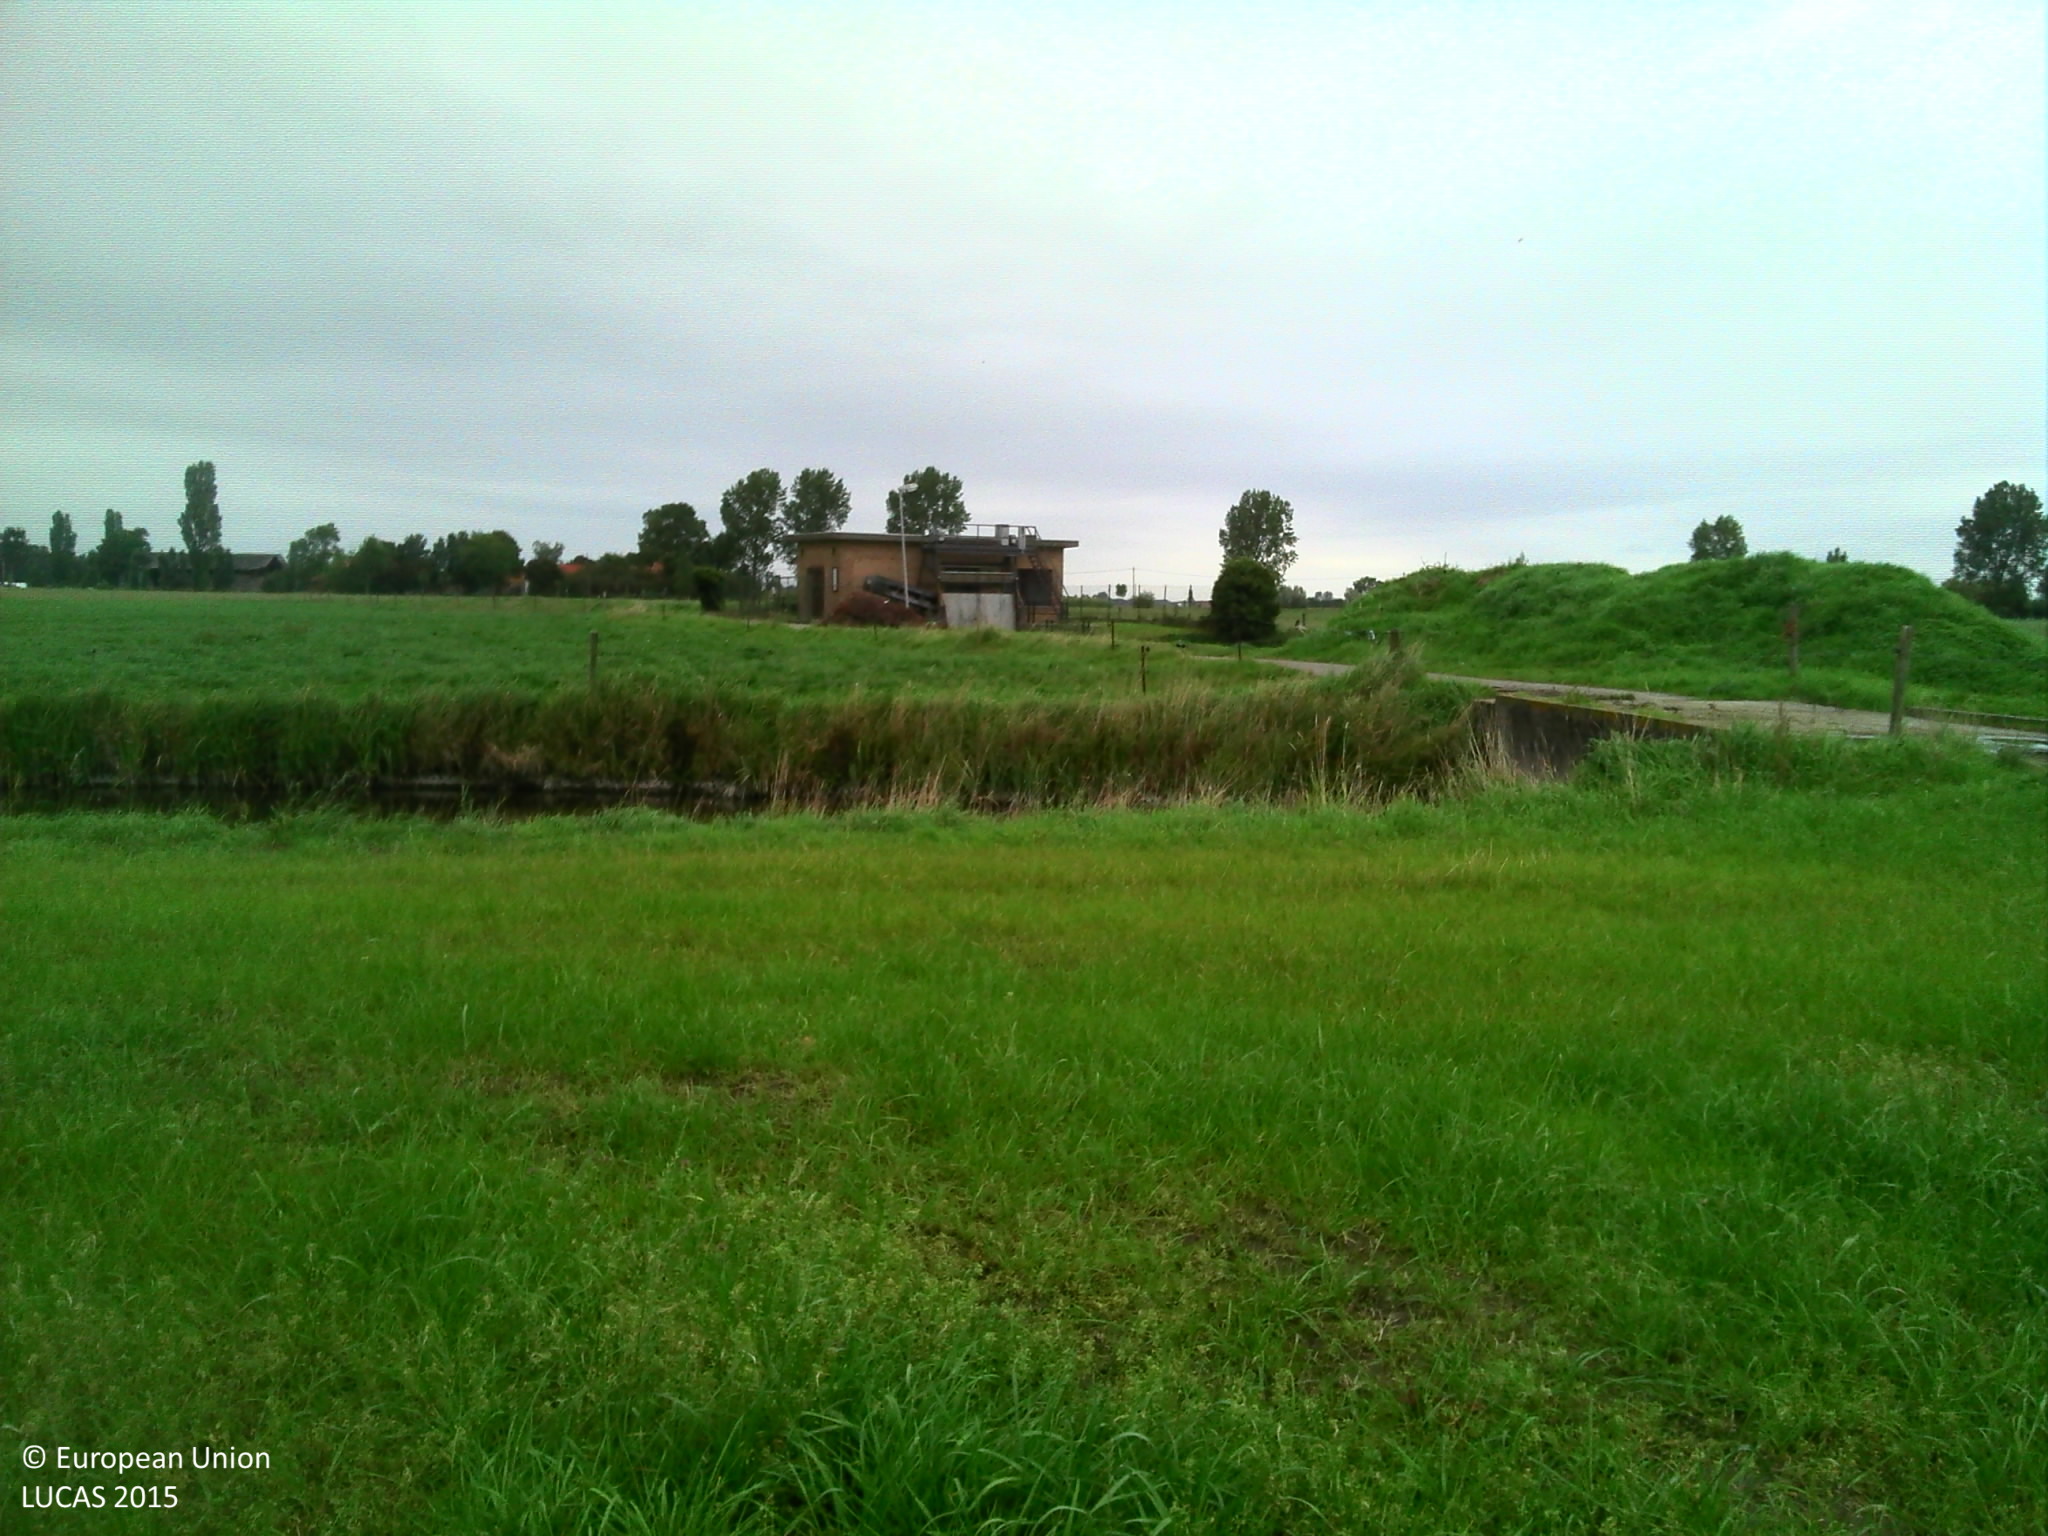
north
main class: Cropland
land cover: Temporary grasslands
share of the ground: > 75 %
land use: Agriculture (excluding fallow land and kitchen gardens)
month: September
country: BE
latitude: 51.1370
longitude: 2.9149
